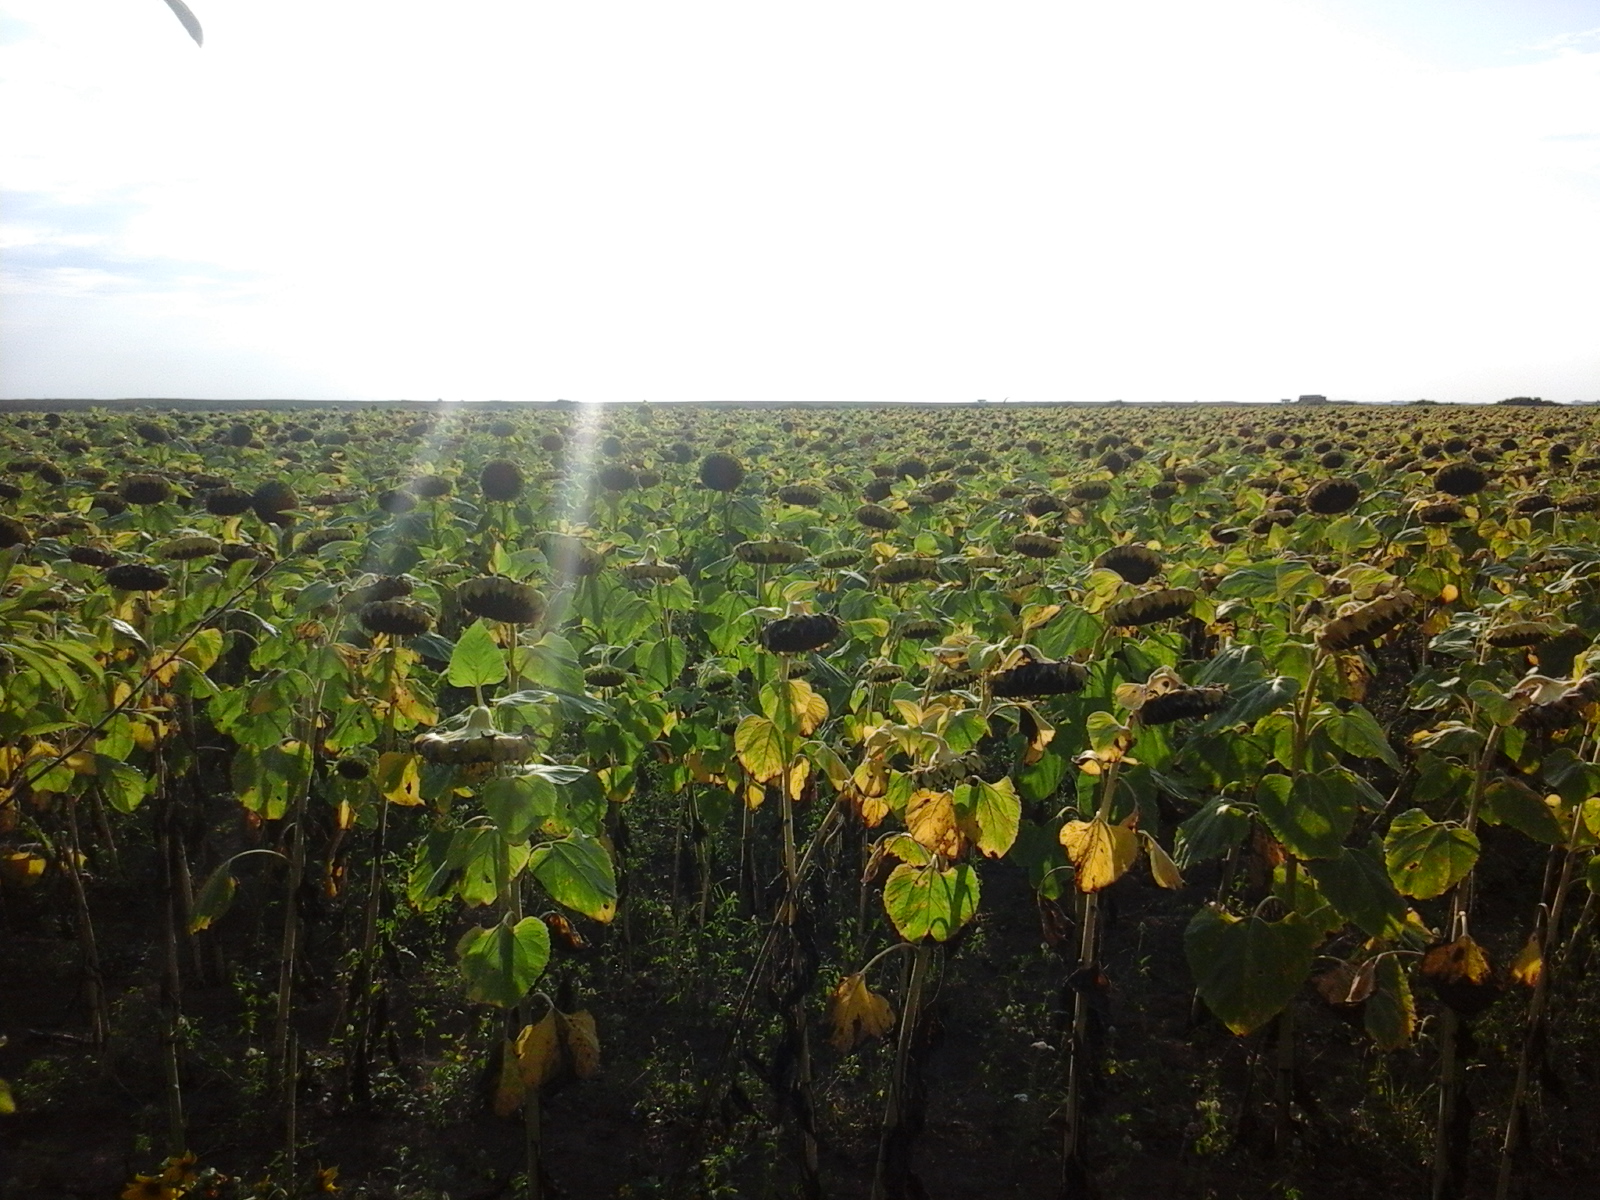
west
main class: Shrubland
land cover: Shrubland without tree cover
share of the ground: > 75 %
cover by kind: shrubs 100 %
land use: Railway transport
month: August
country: RO
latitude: 46.7011
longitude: 21.5883
